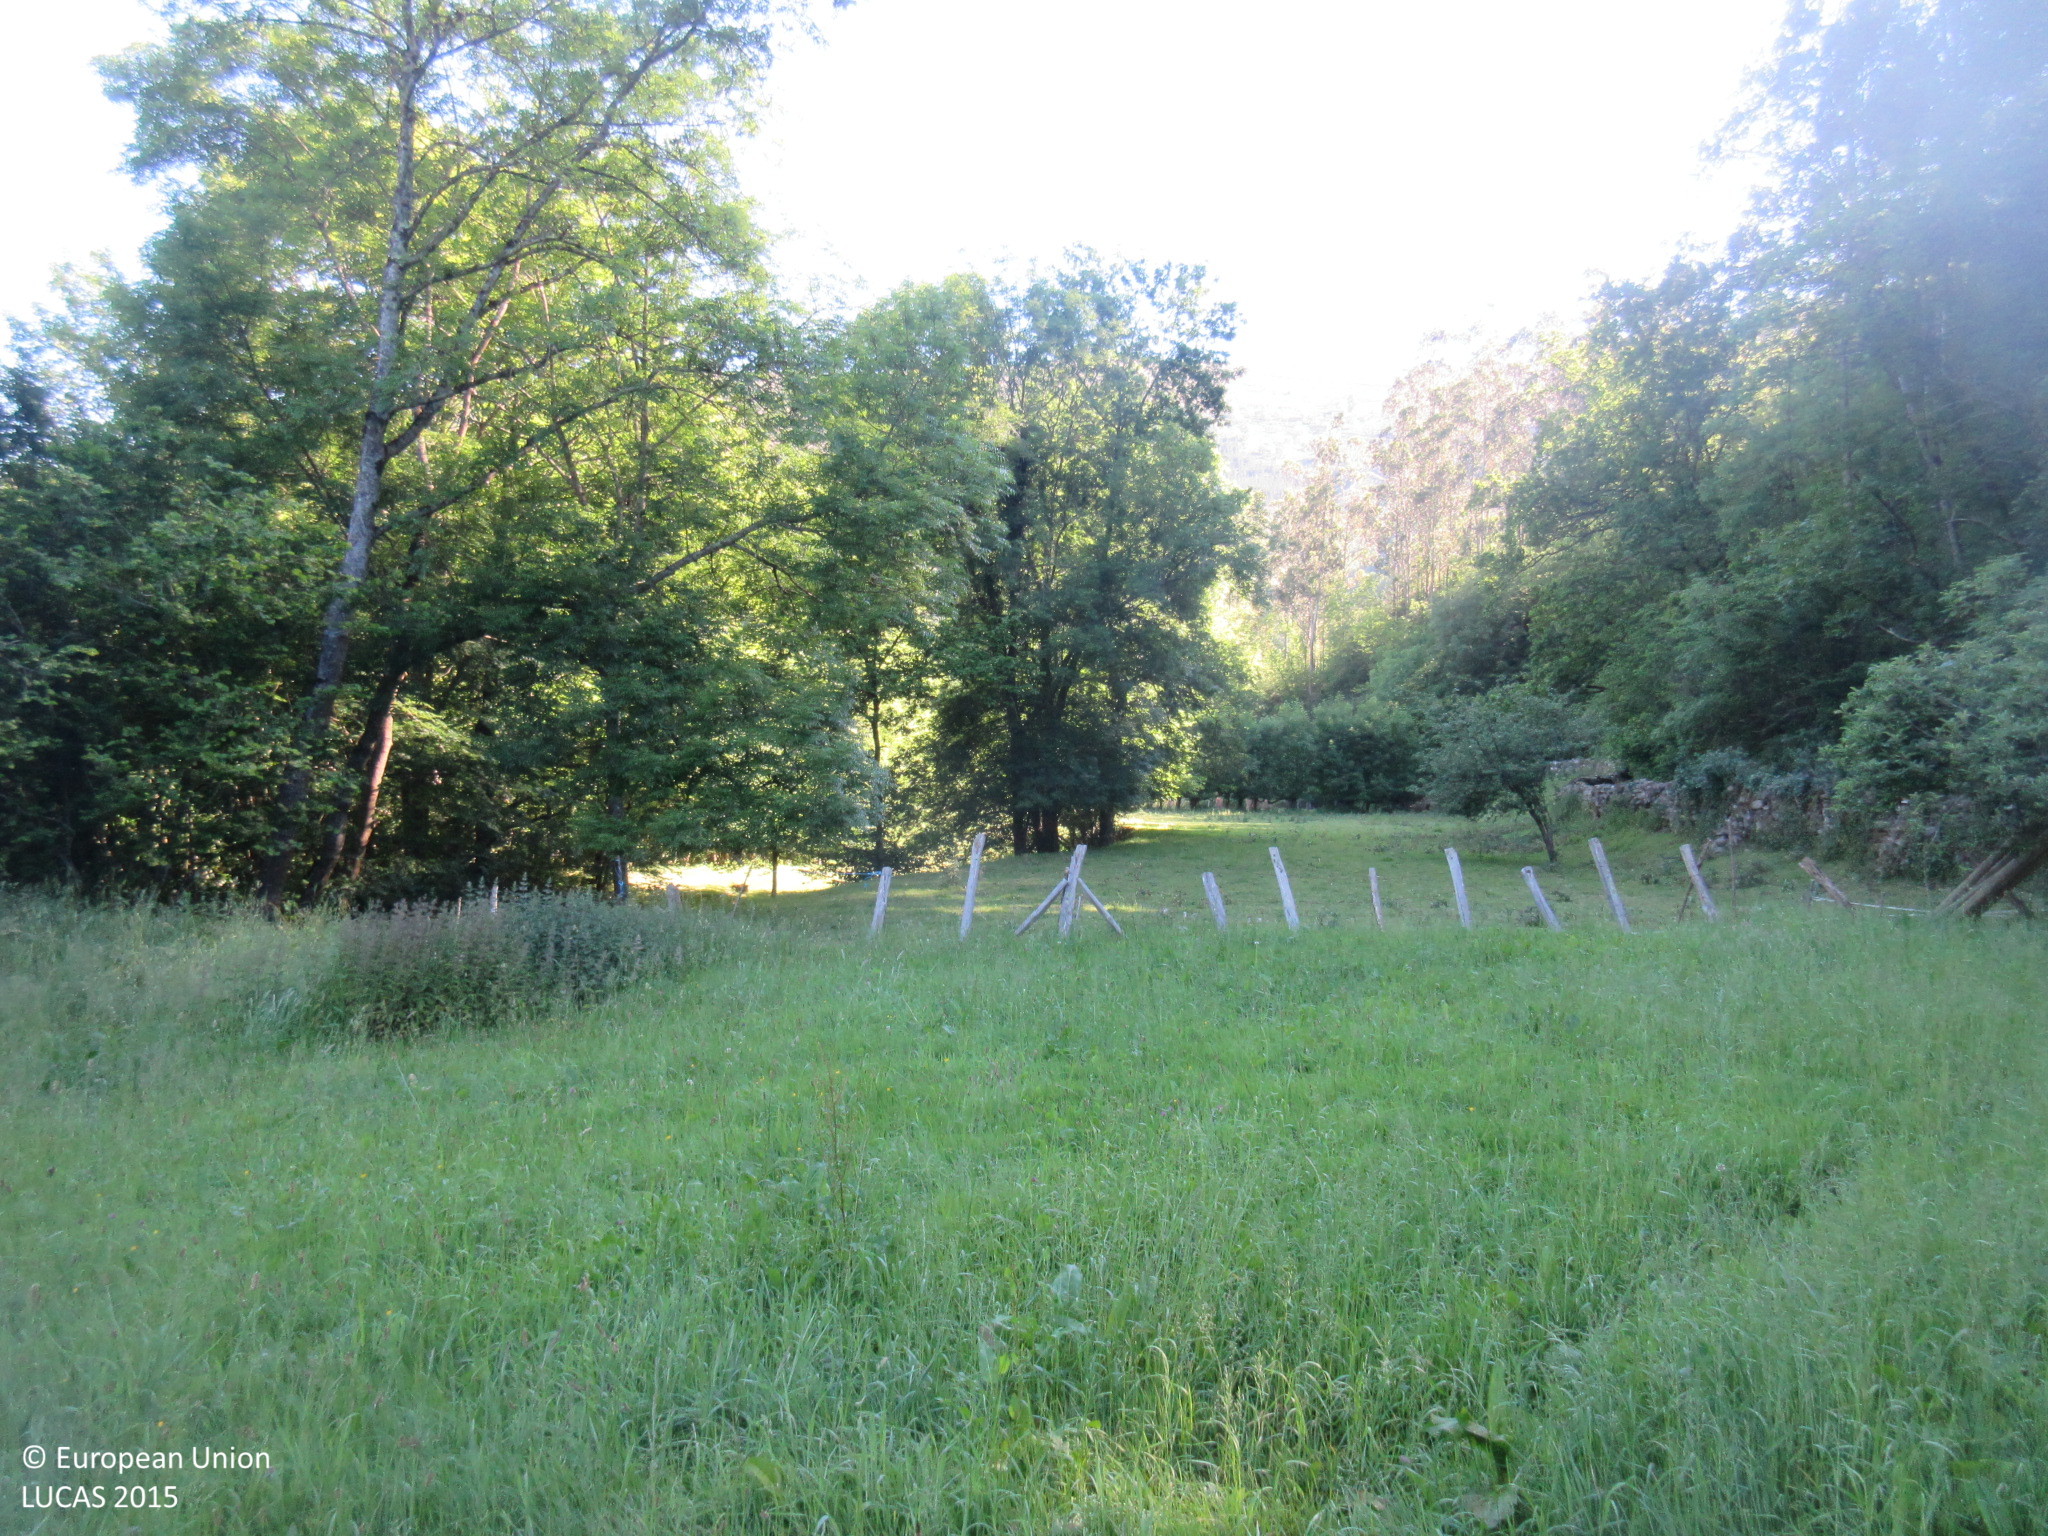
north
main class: Grassland
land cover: Grassland without tree/shrub cover
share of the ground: > 75 %
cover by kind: herbaceous plants 100 %
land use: Agriculture (excluding fallow land and kitchen gardens)
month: June
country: ES
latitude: 43.2300
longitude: -4.4015
